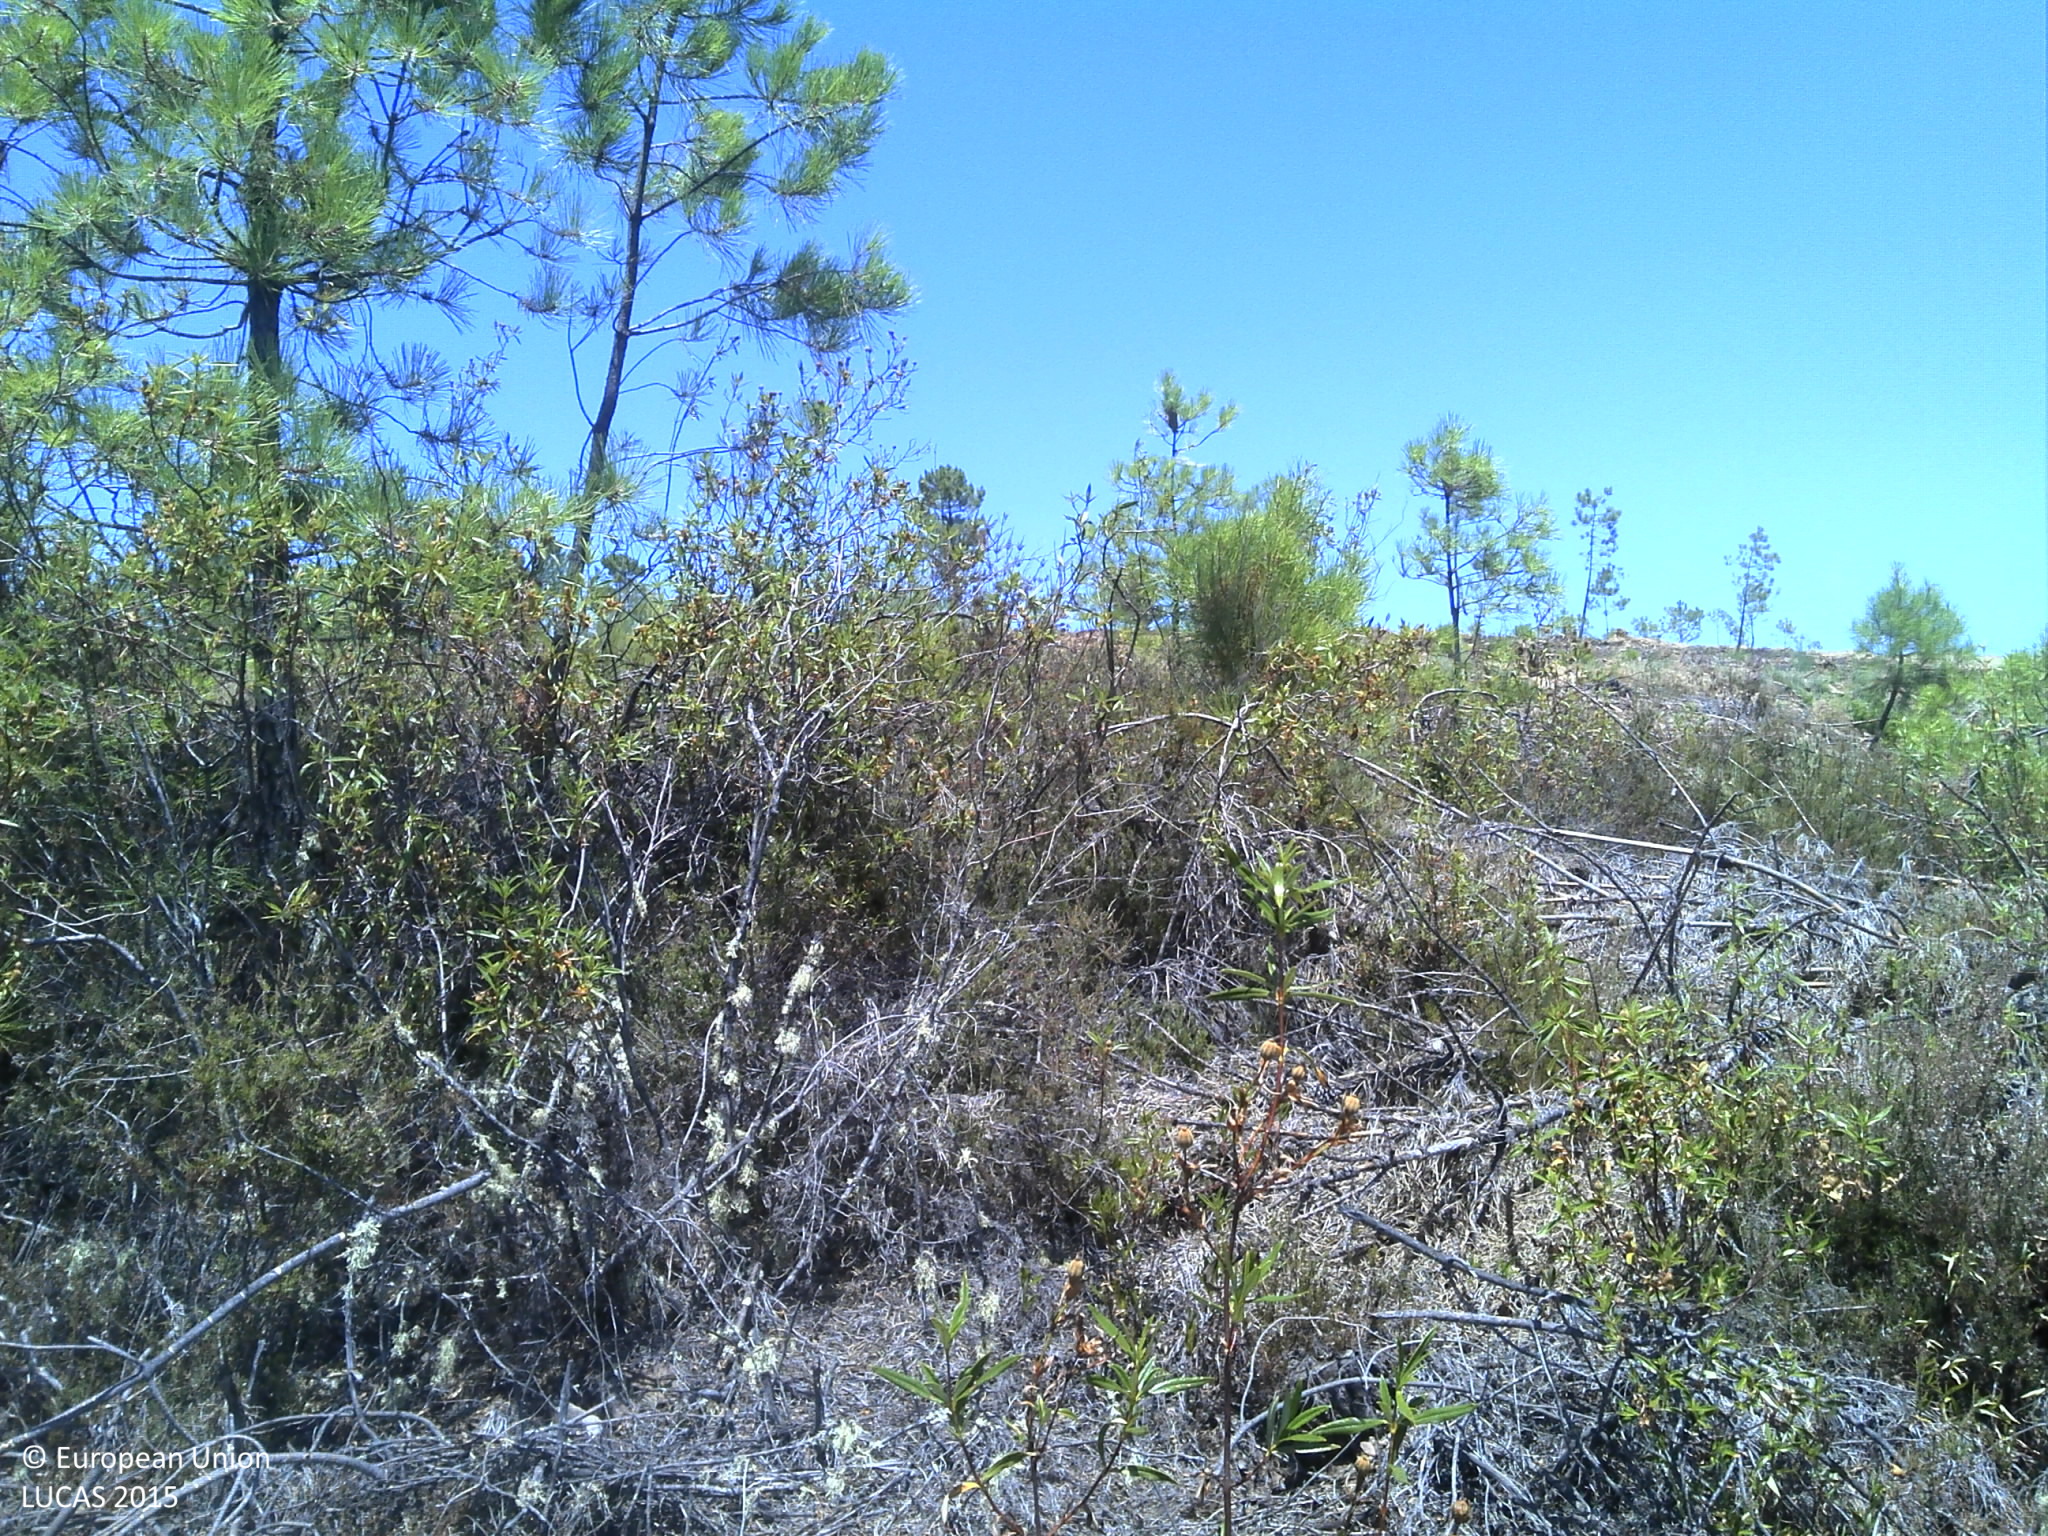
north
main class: Shrubland
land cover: Shrubland with sparse tree cover
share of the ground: 50 - 75 %
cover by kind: shrubs 85 %, coniferous forest trees 5 %, unconsolidated bare surface 5 %
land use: Abandoned areas
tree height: < 5 m
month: July
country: PT
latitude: 40.1737
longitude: -7.7136
